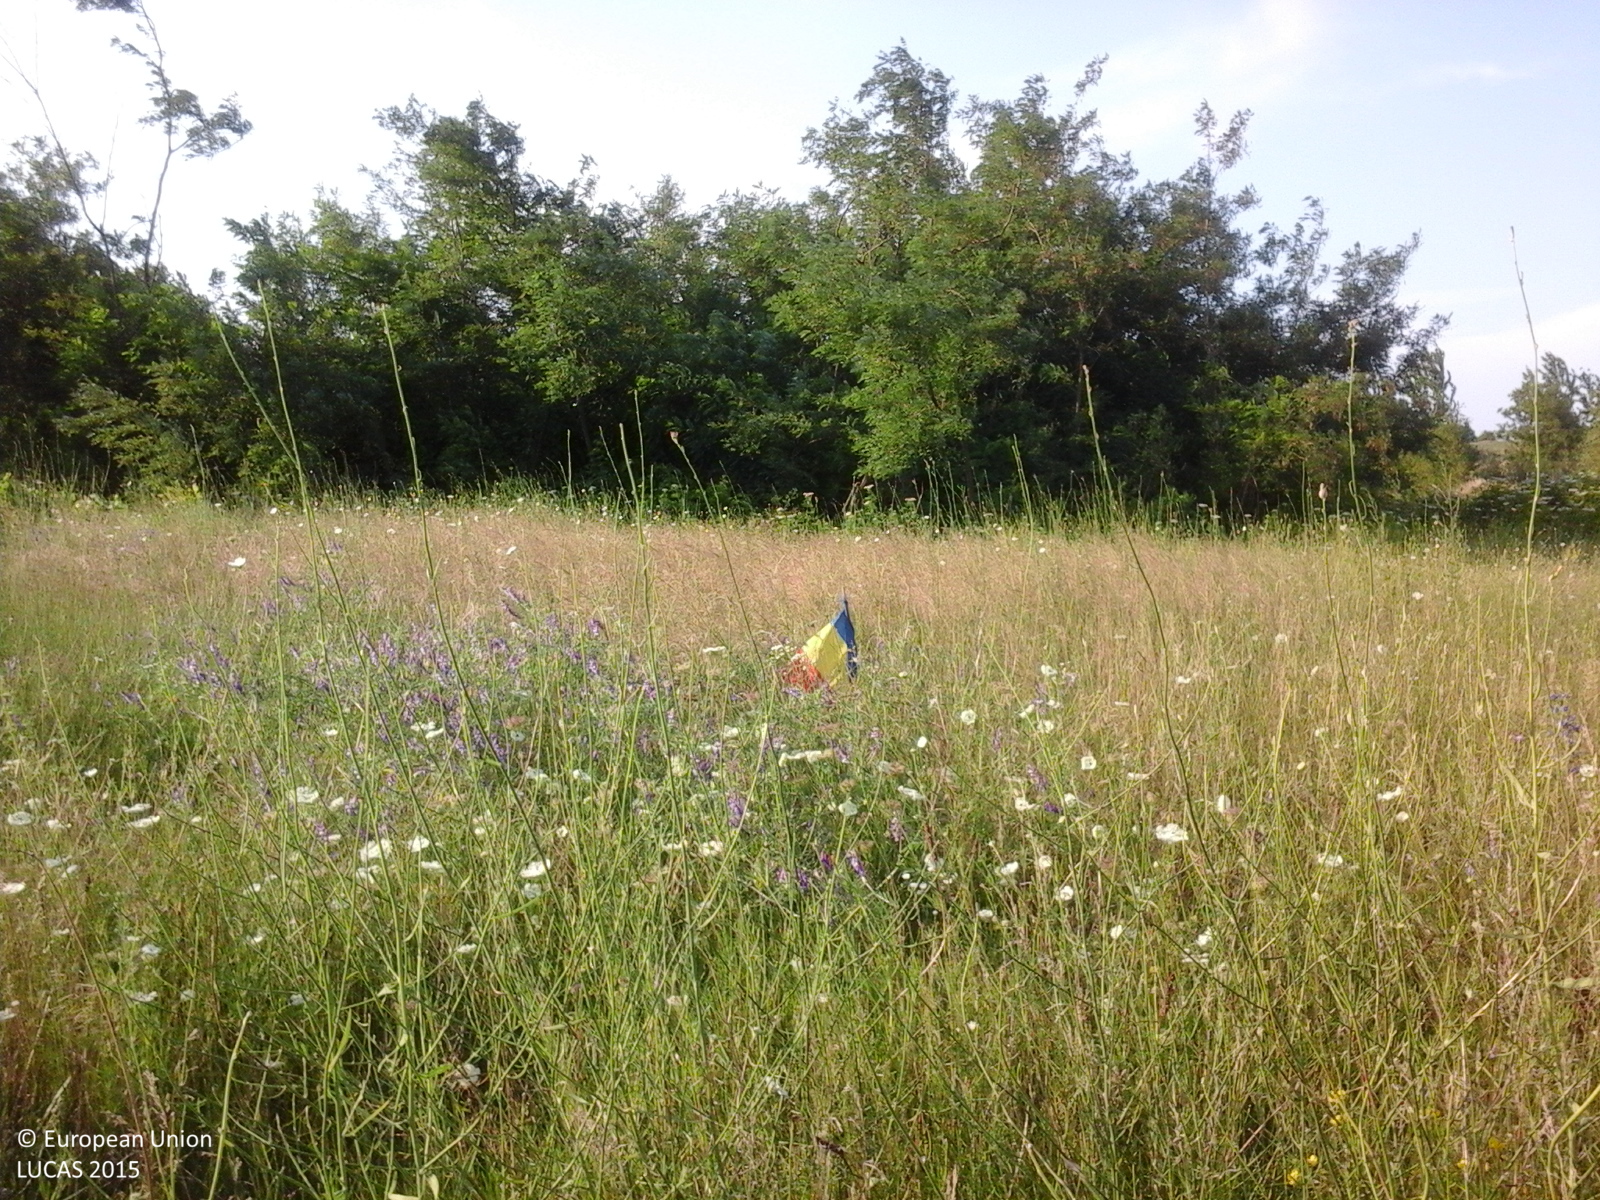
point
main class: Grassland
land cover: Grassland without tree/shrub cover
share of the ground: > 75 %
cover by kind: herbaceous plants 100 %
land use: Agriculture (excluding fallow land and kitchen gardens)
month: July
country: RO
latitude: 43.7729
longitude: 24.1842
